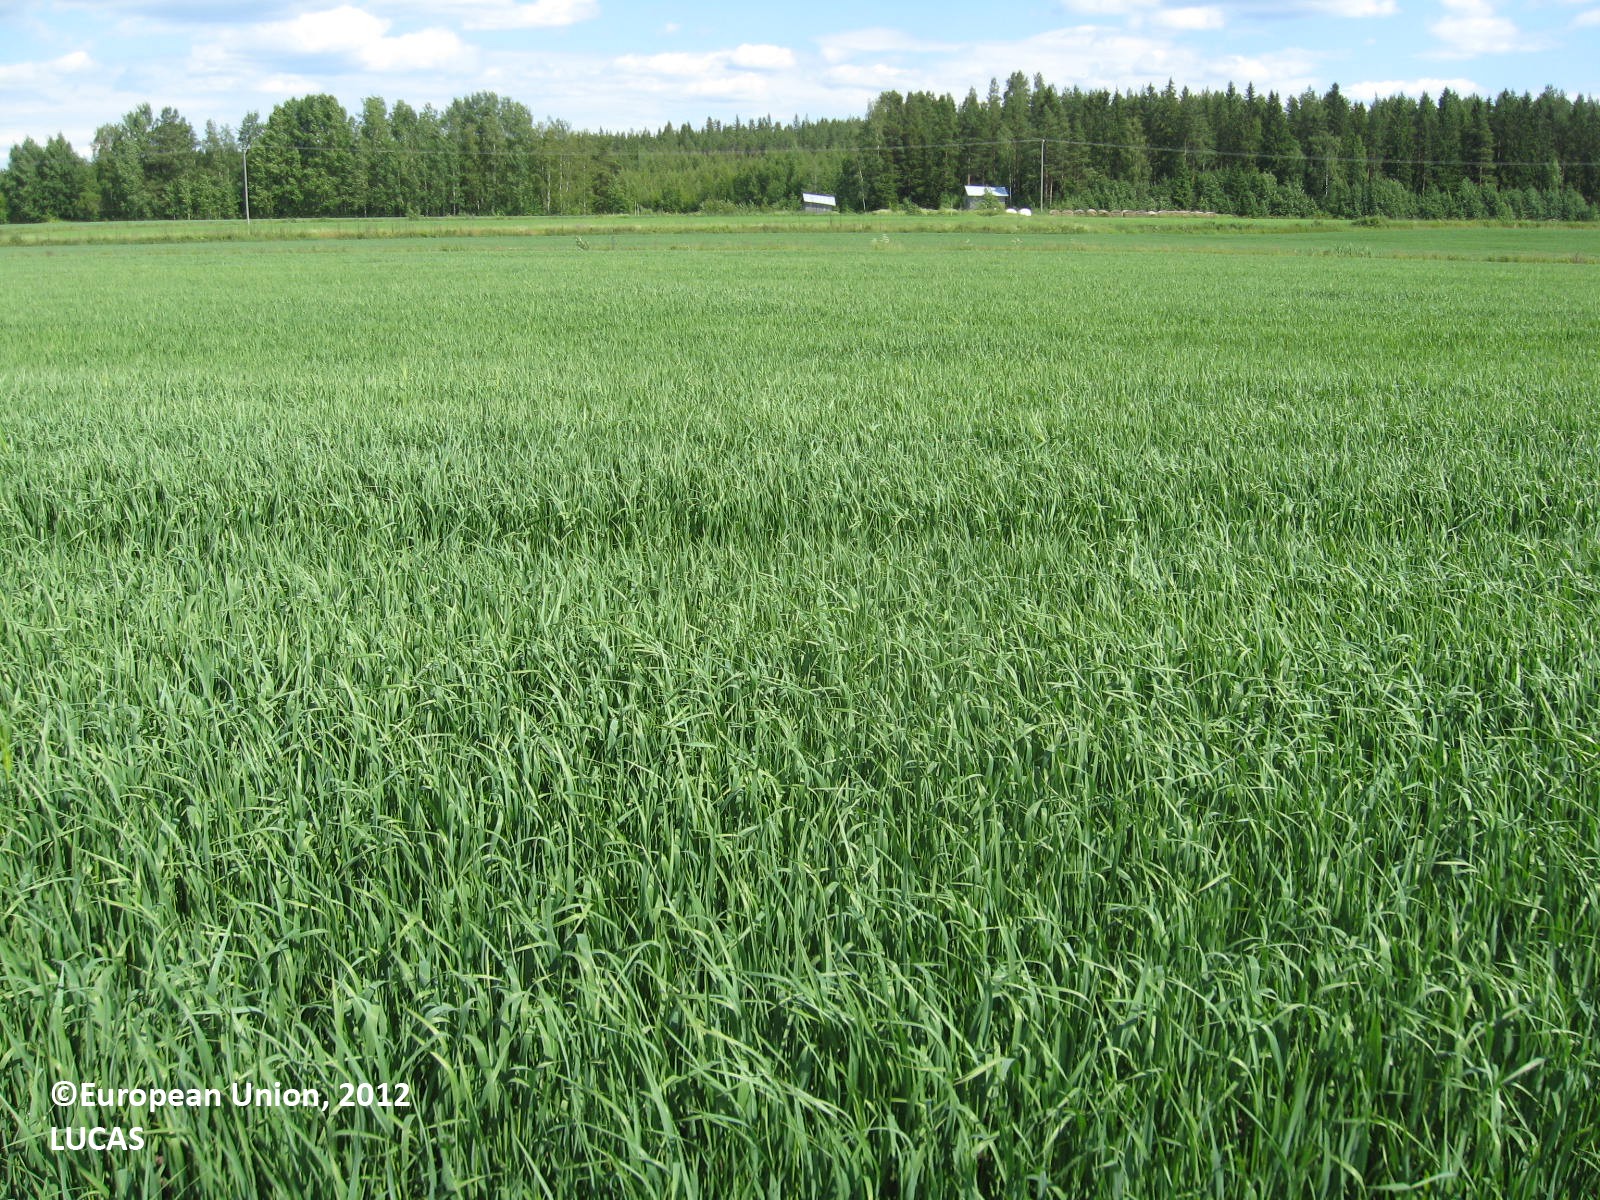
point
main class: Cropland
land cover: Oats
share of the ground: > 75 %
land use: Agriculture (excluding fallow land and kitchen gardens)
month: July
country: FI
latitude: 62.6222
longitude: 22.4709
